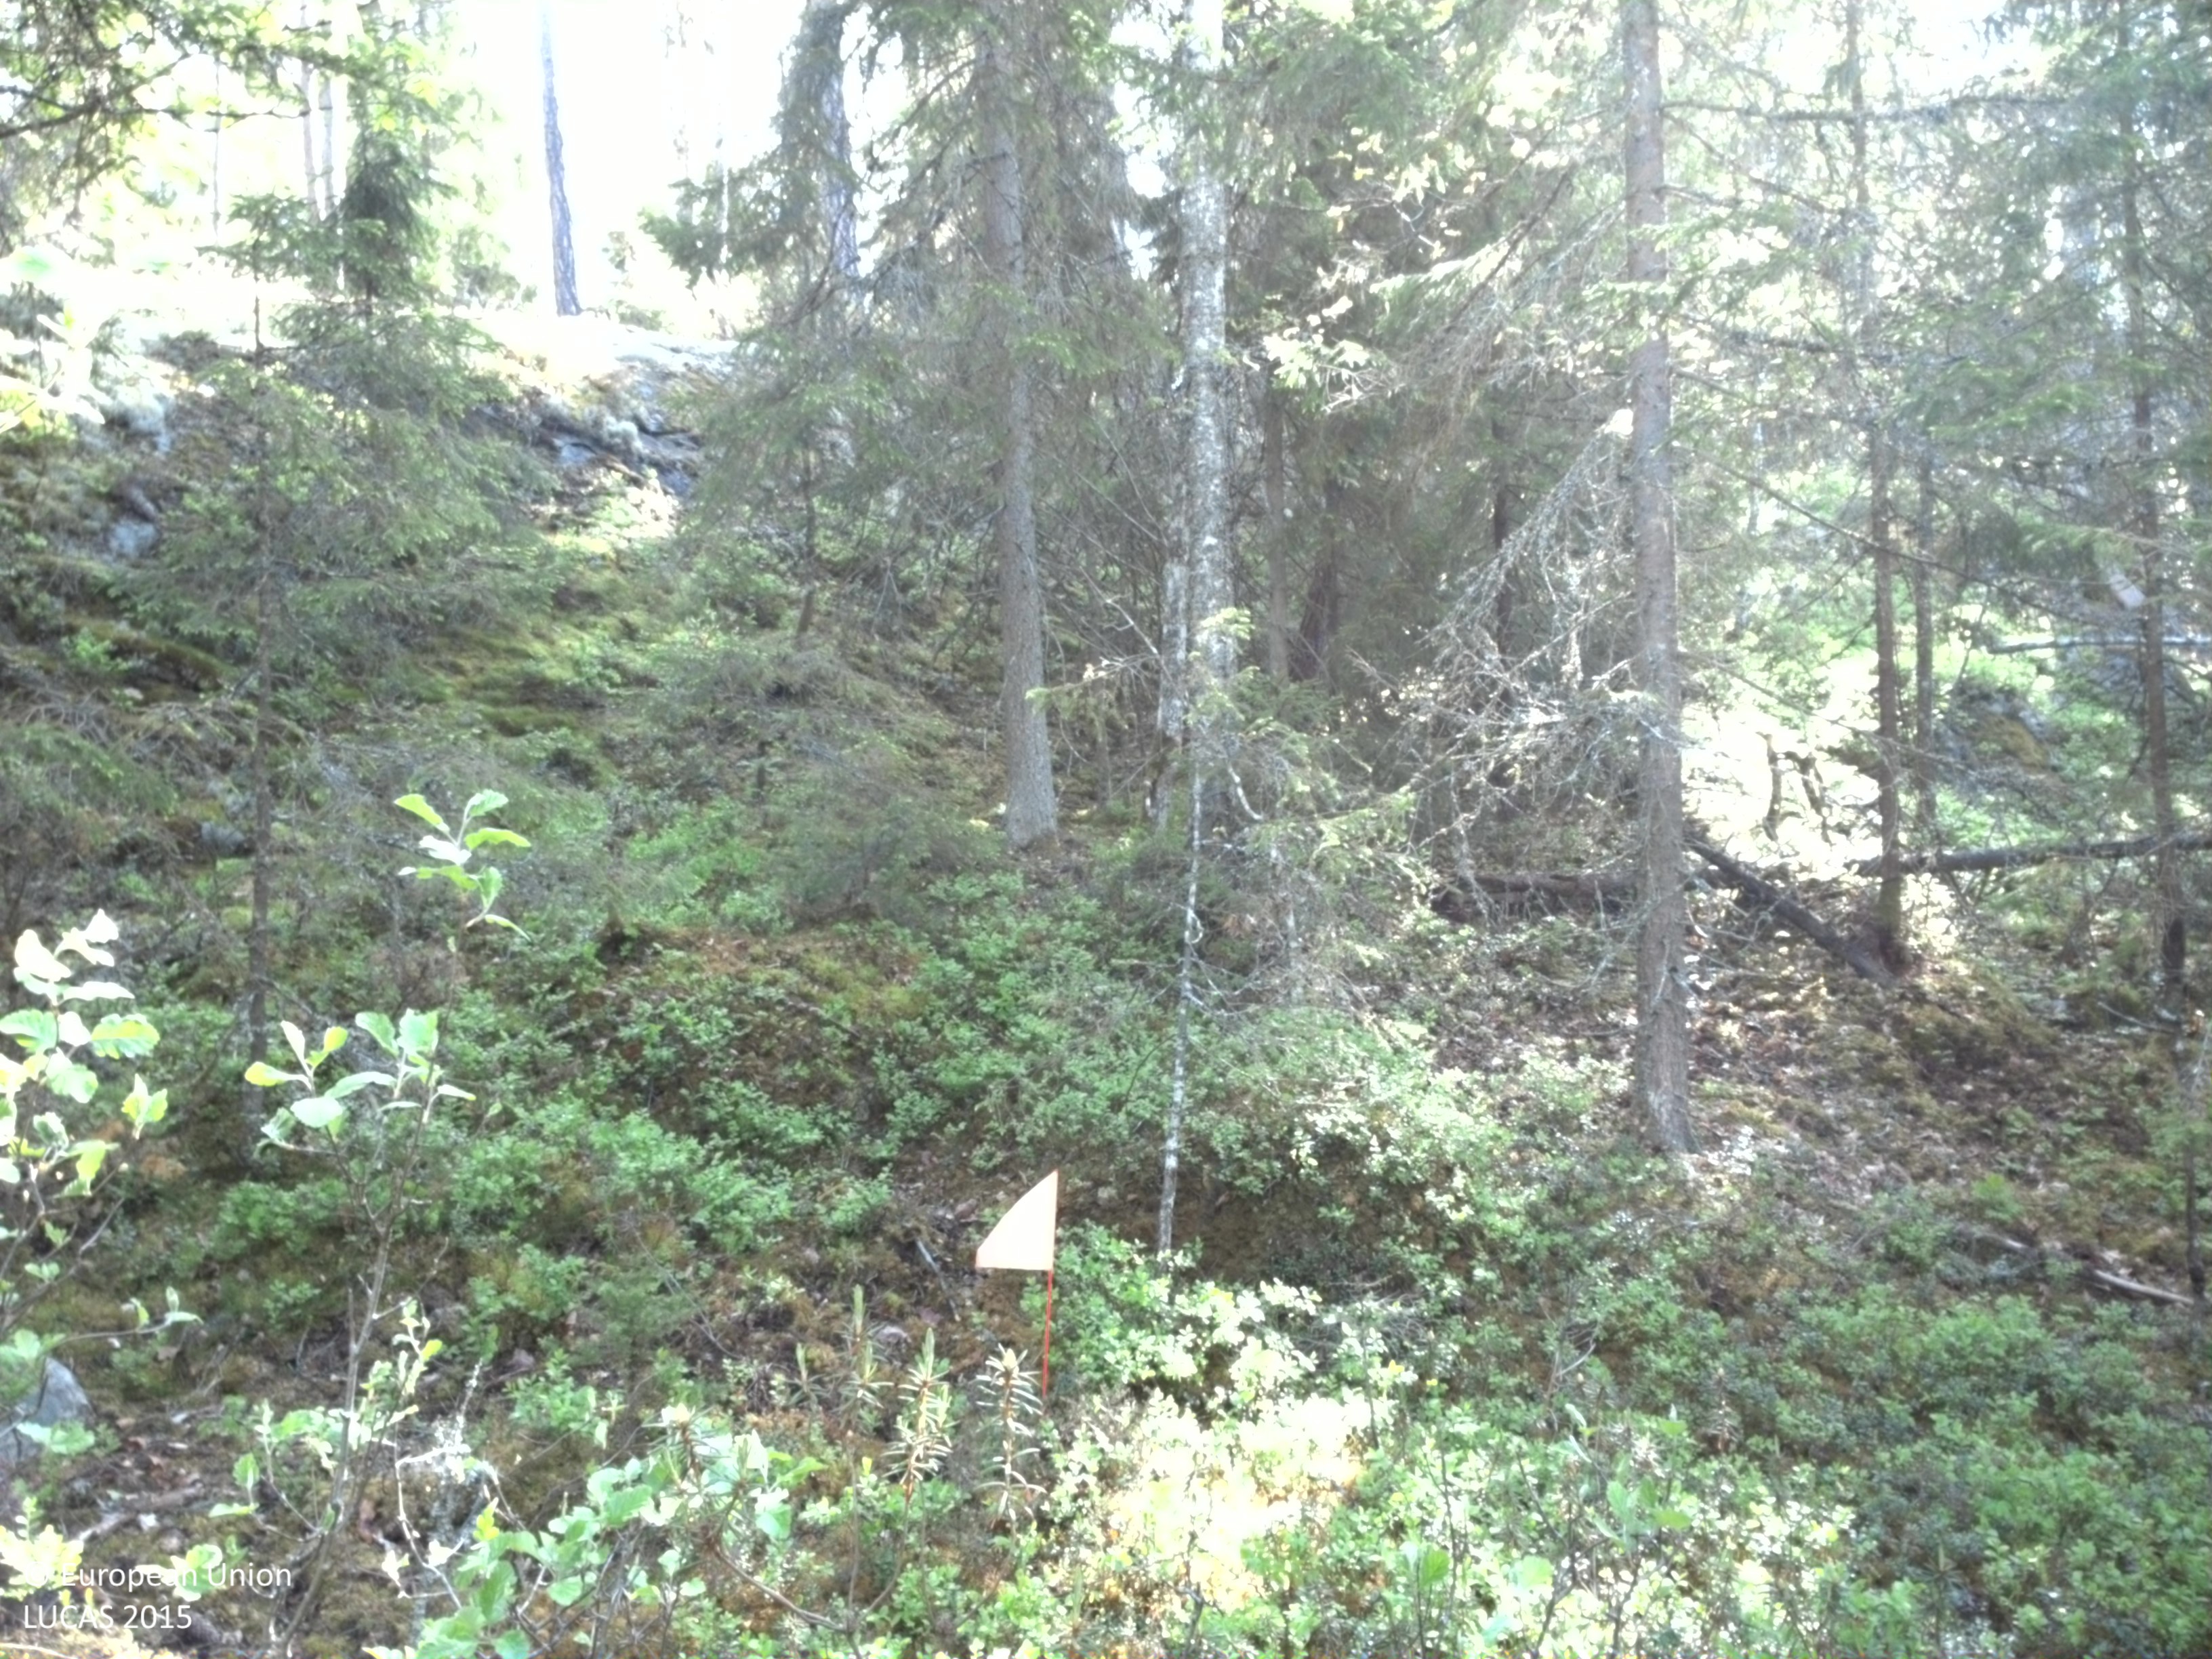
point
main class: Woodland
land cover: Spruce dominated coniferous woodland
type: boreal forest
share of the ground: 50 - 75 %
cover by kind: coniferous forest trees 40 %, lichens and mosses 30 %, shrubs 15 %, broadleaved forest trees 10 %, herbaceous plants 5 %
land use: Forestry
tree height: > 5 m
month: May
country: SE
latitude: 57.3705
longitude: 15.4345
